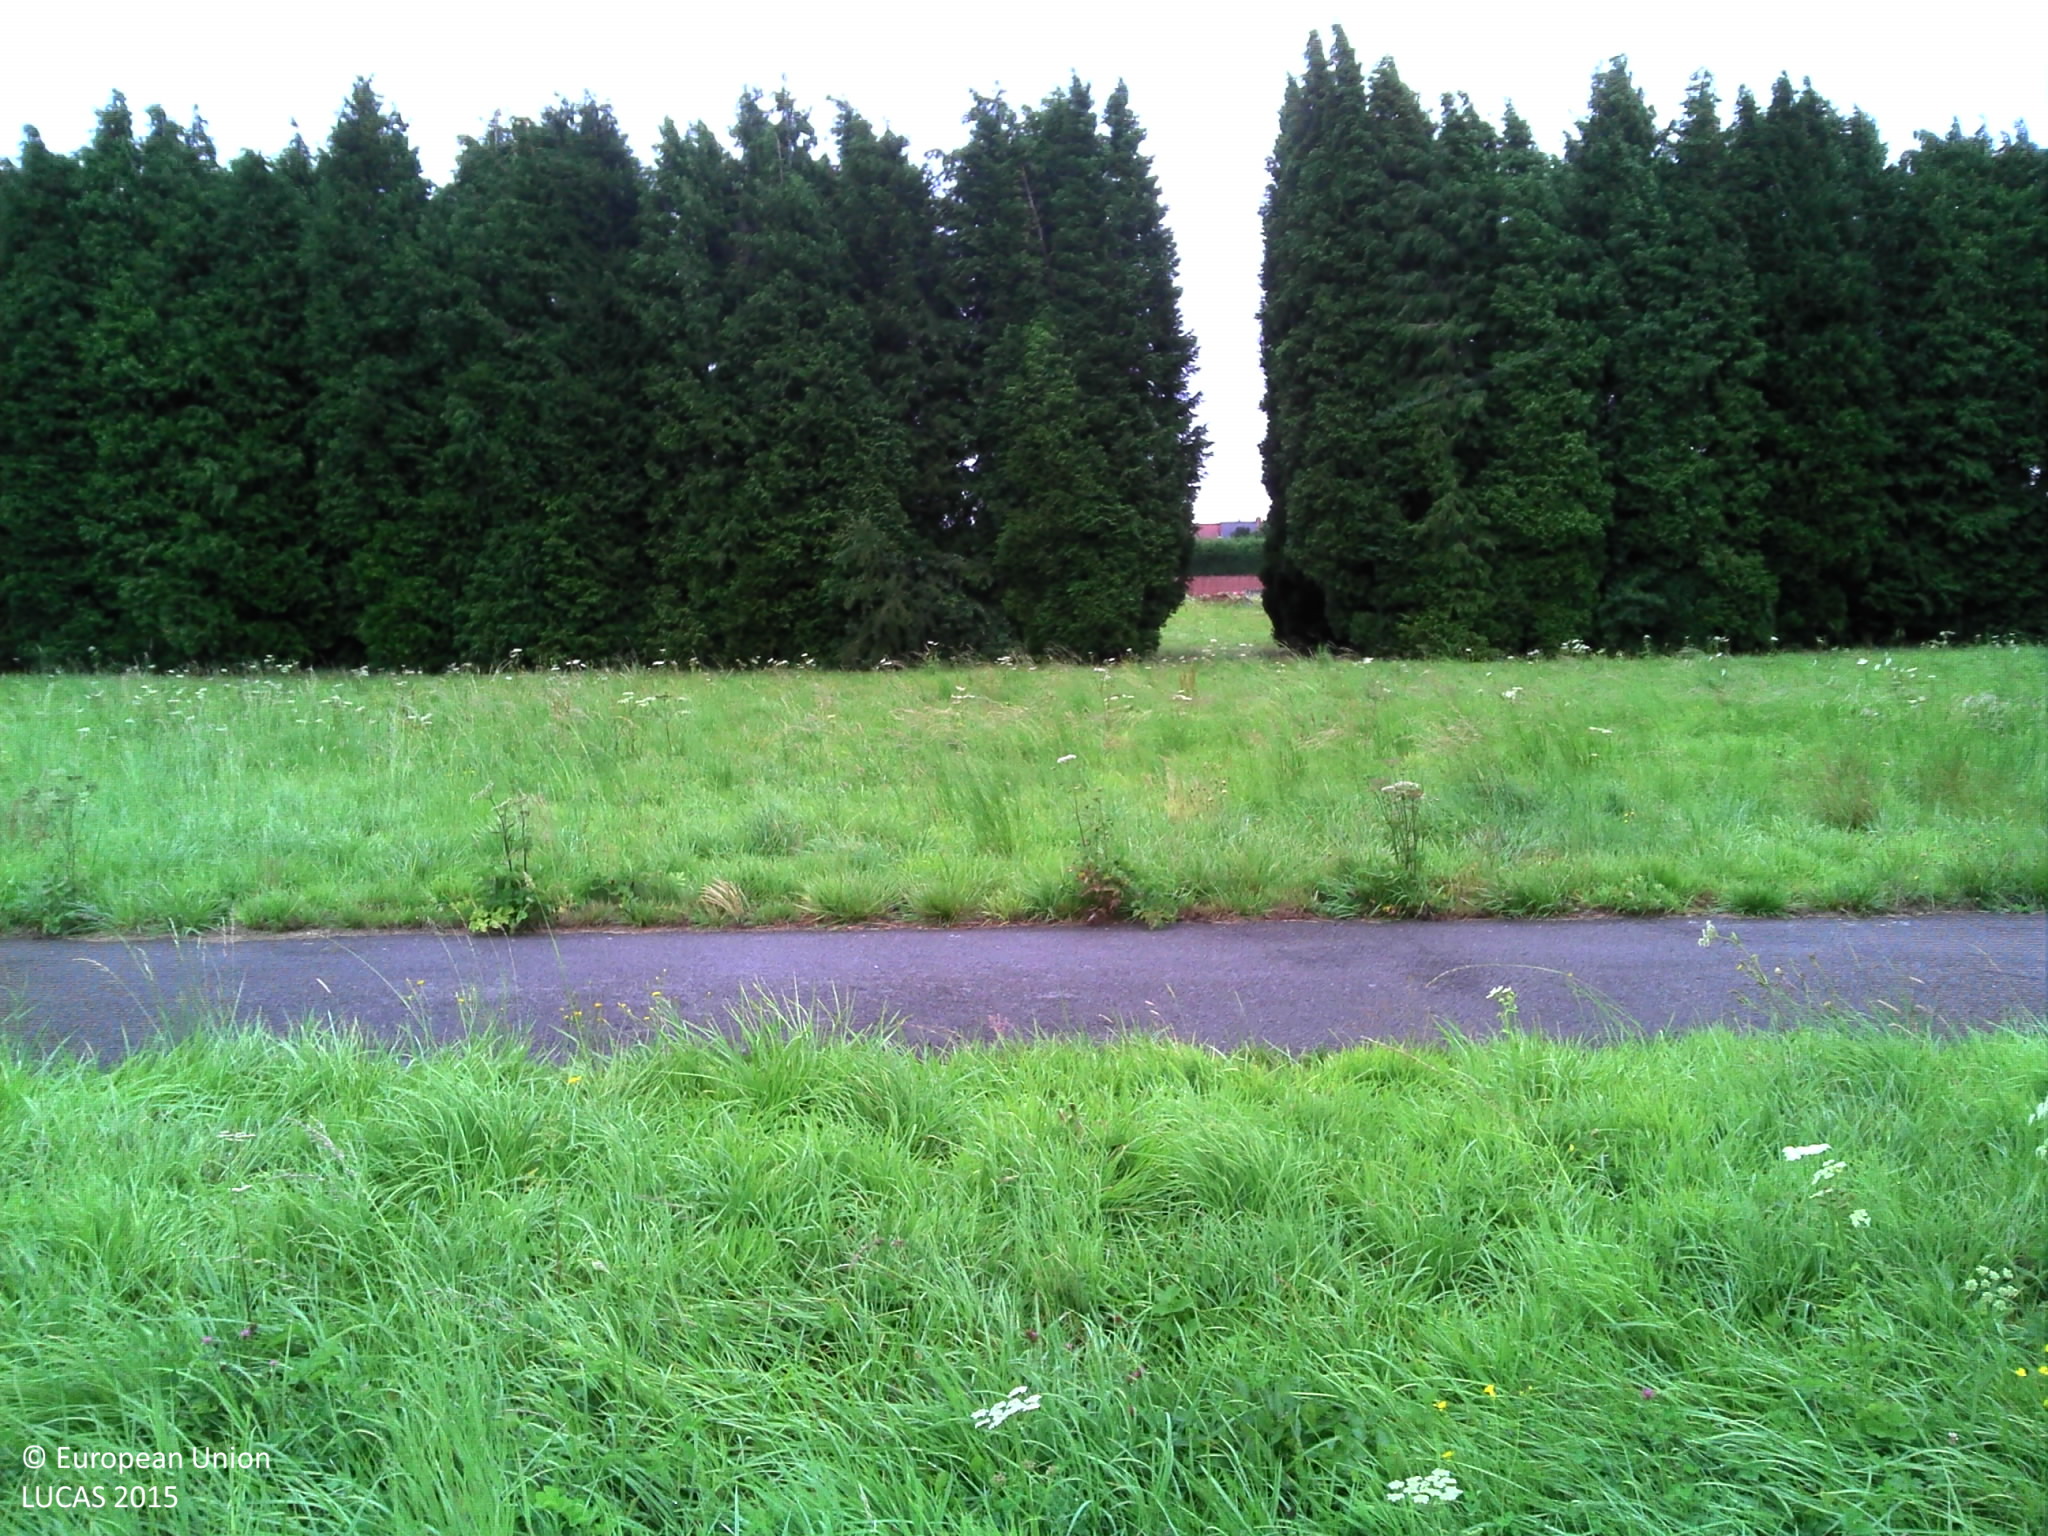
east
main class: Grassland
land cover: Grassland without tree/shrub cover
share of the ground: > 75 %
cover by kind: herbaceous plants 100 %
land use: Community services
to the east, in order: Grassland without tree/shrub cover; Tracks; Grassland without tree/shrub cover; Lines of trees; Tracks; Lines of trees; Grassland without tree/shrub cover; Tracks; Grassland without tree/shrub cover; Artificial constructions in urban areas; Grassland without tree/shrub cover; Artificial constructions in urban areas
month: July
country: BE
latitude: 50.4861
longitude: 4.5415
